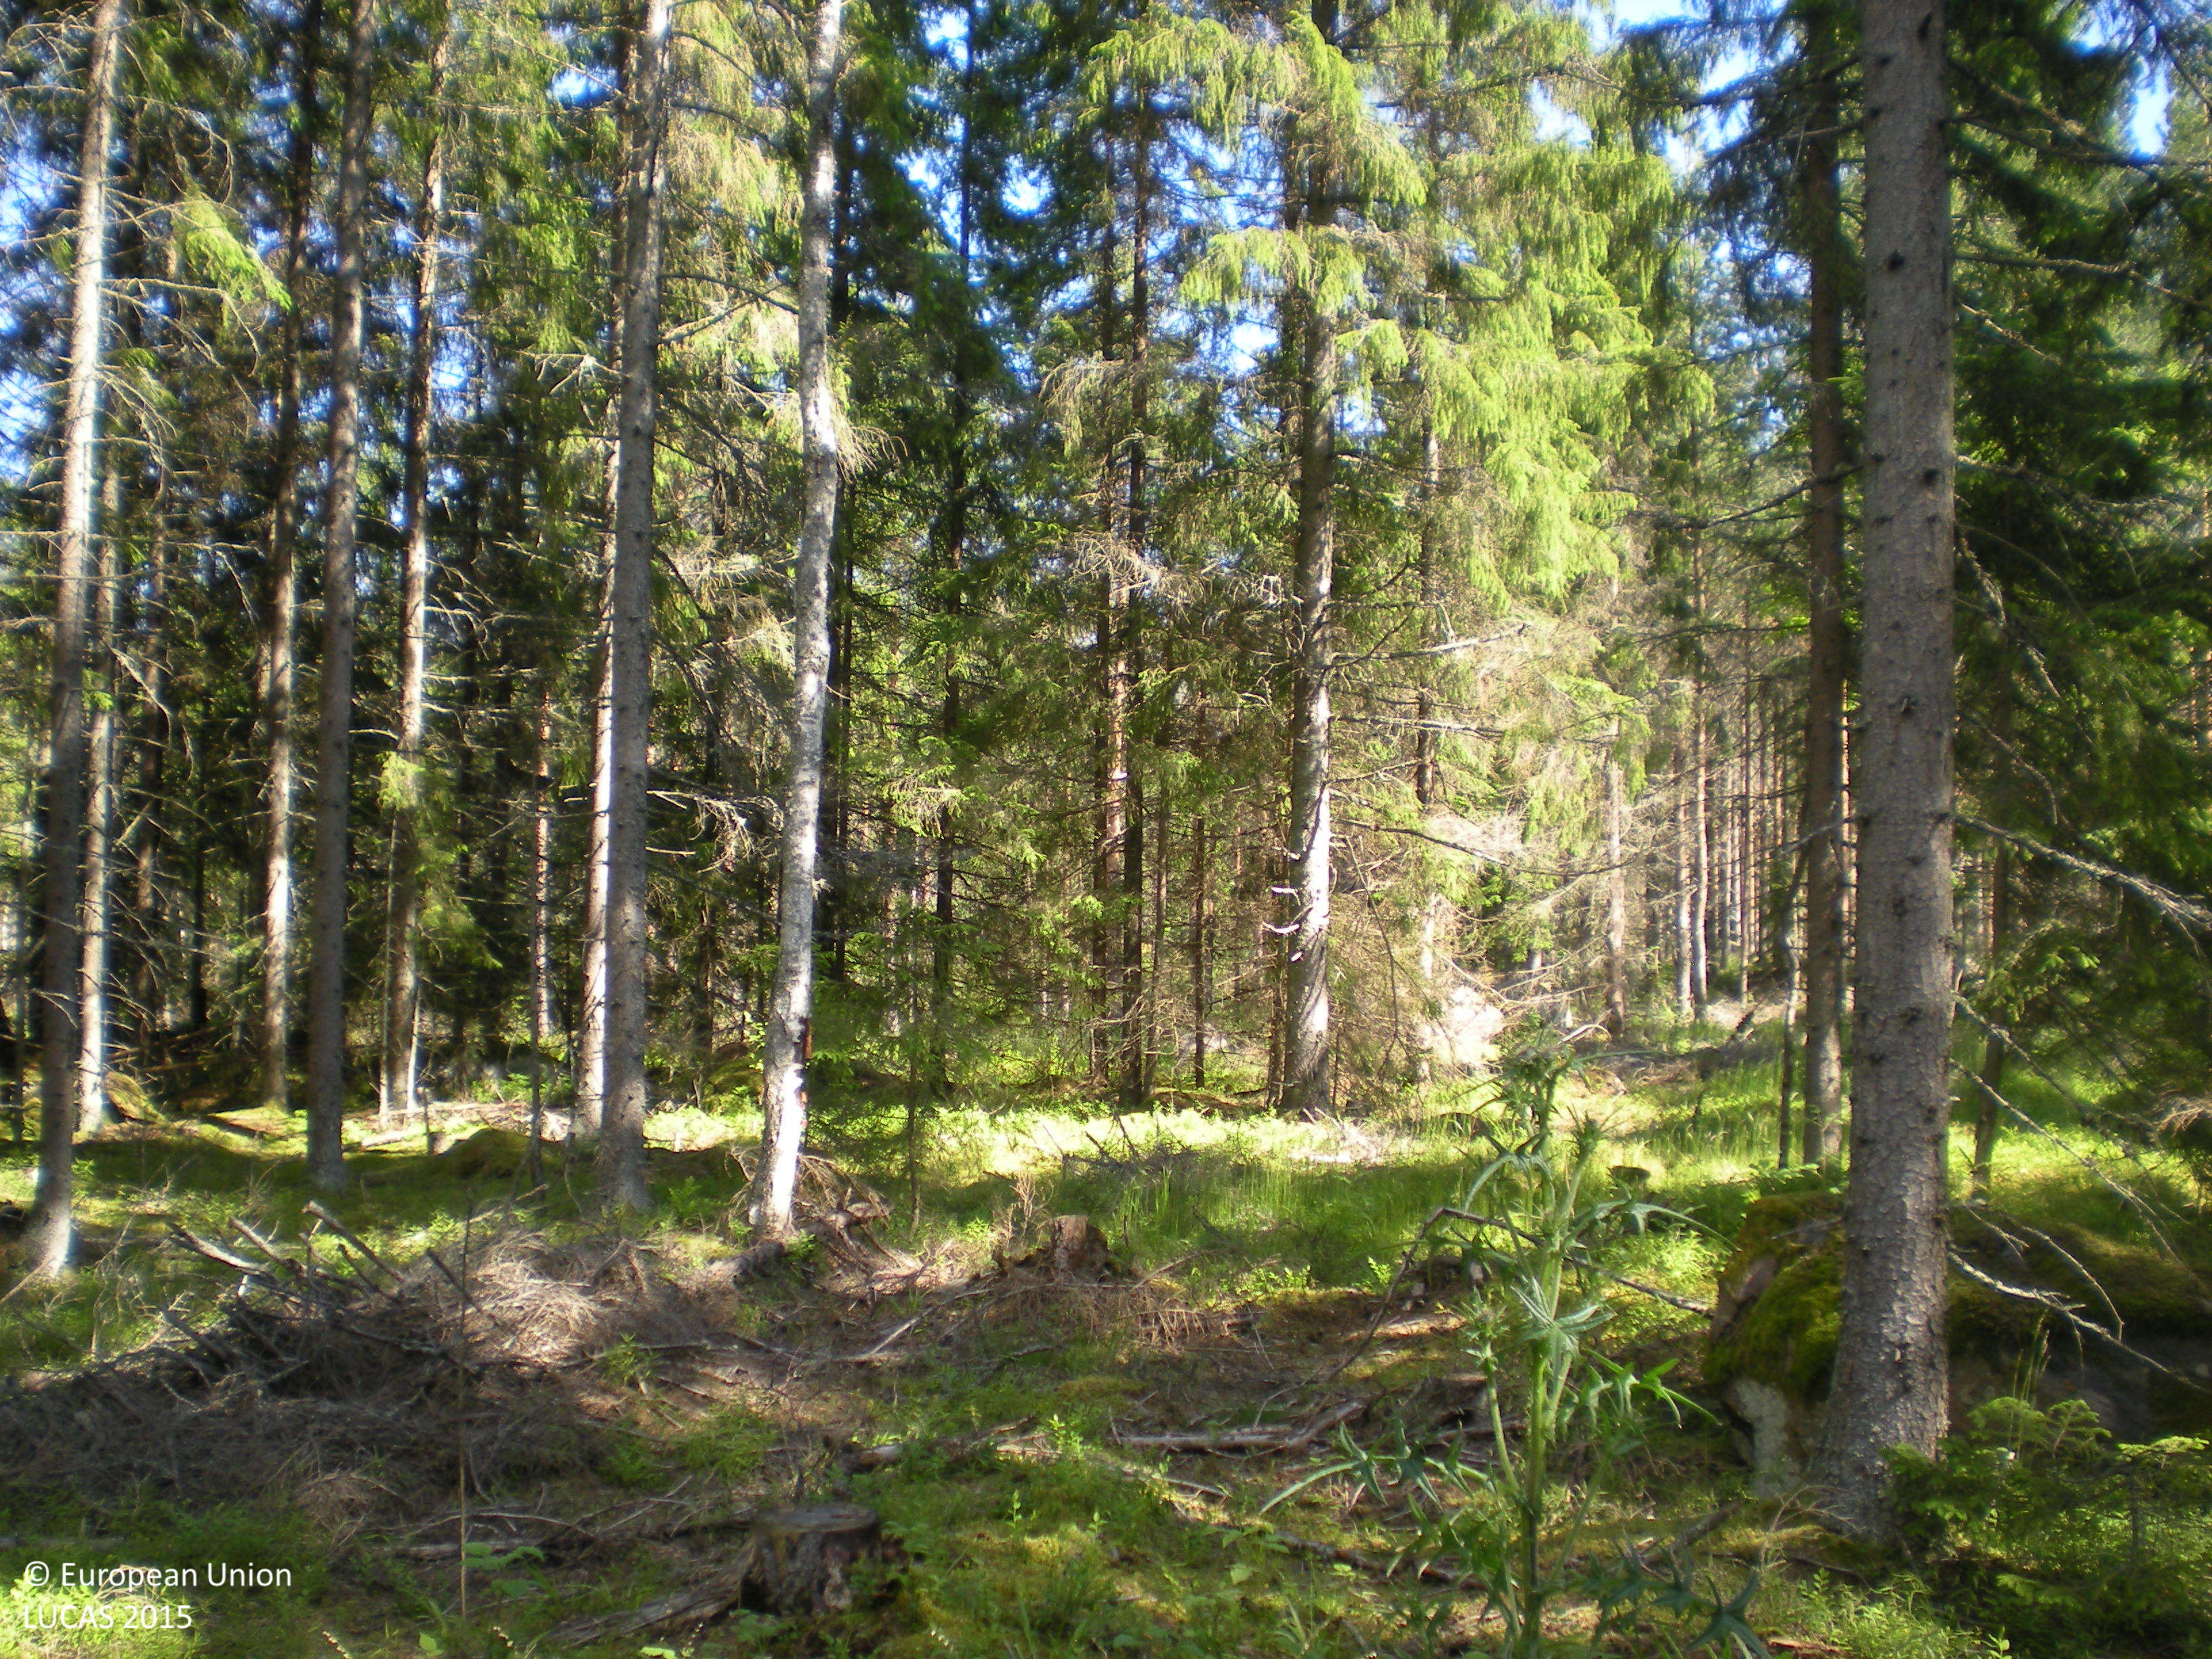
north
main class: Woodland
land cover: Spruce dominated coniferous woodland
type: boreal forest
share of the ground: 50 - 75 %
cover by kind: coniferous forest trees 65 %, shrubs 10 %, broadleaved forest trees 5 %, herbaceous plants 5 %, lichens and mosses 5 %, consolidated bare surface 5 %
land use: Forestry
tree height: > 5 m
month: June
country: SE
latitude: 60.4378
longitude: 18.0793
